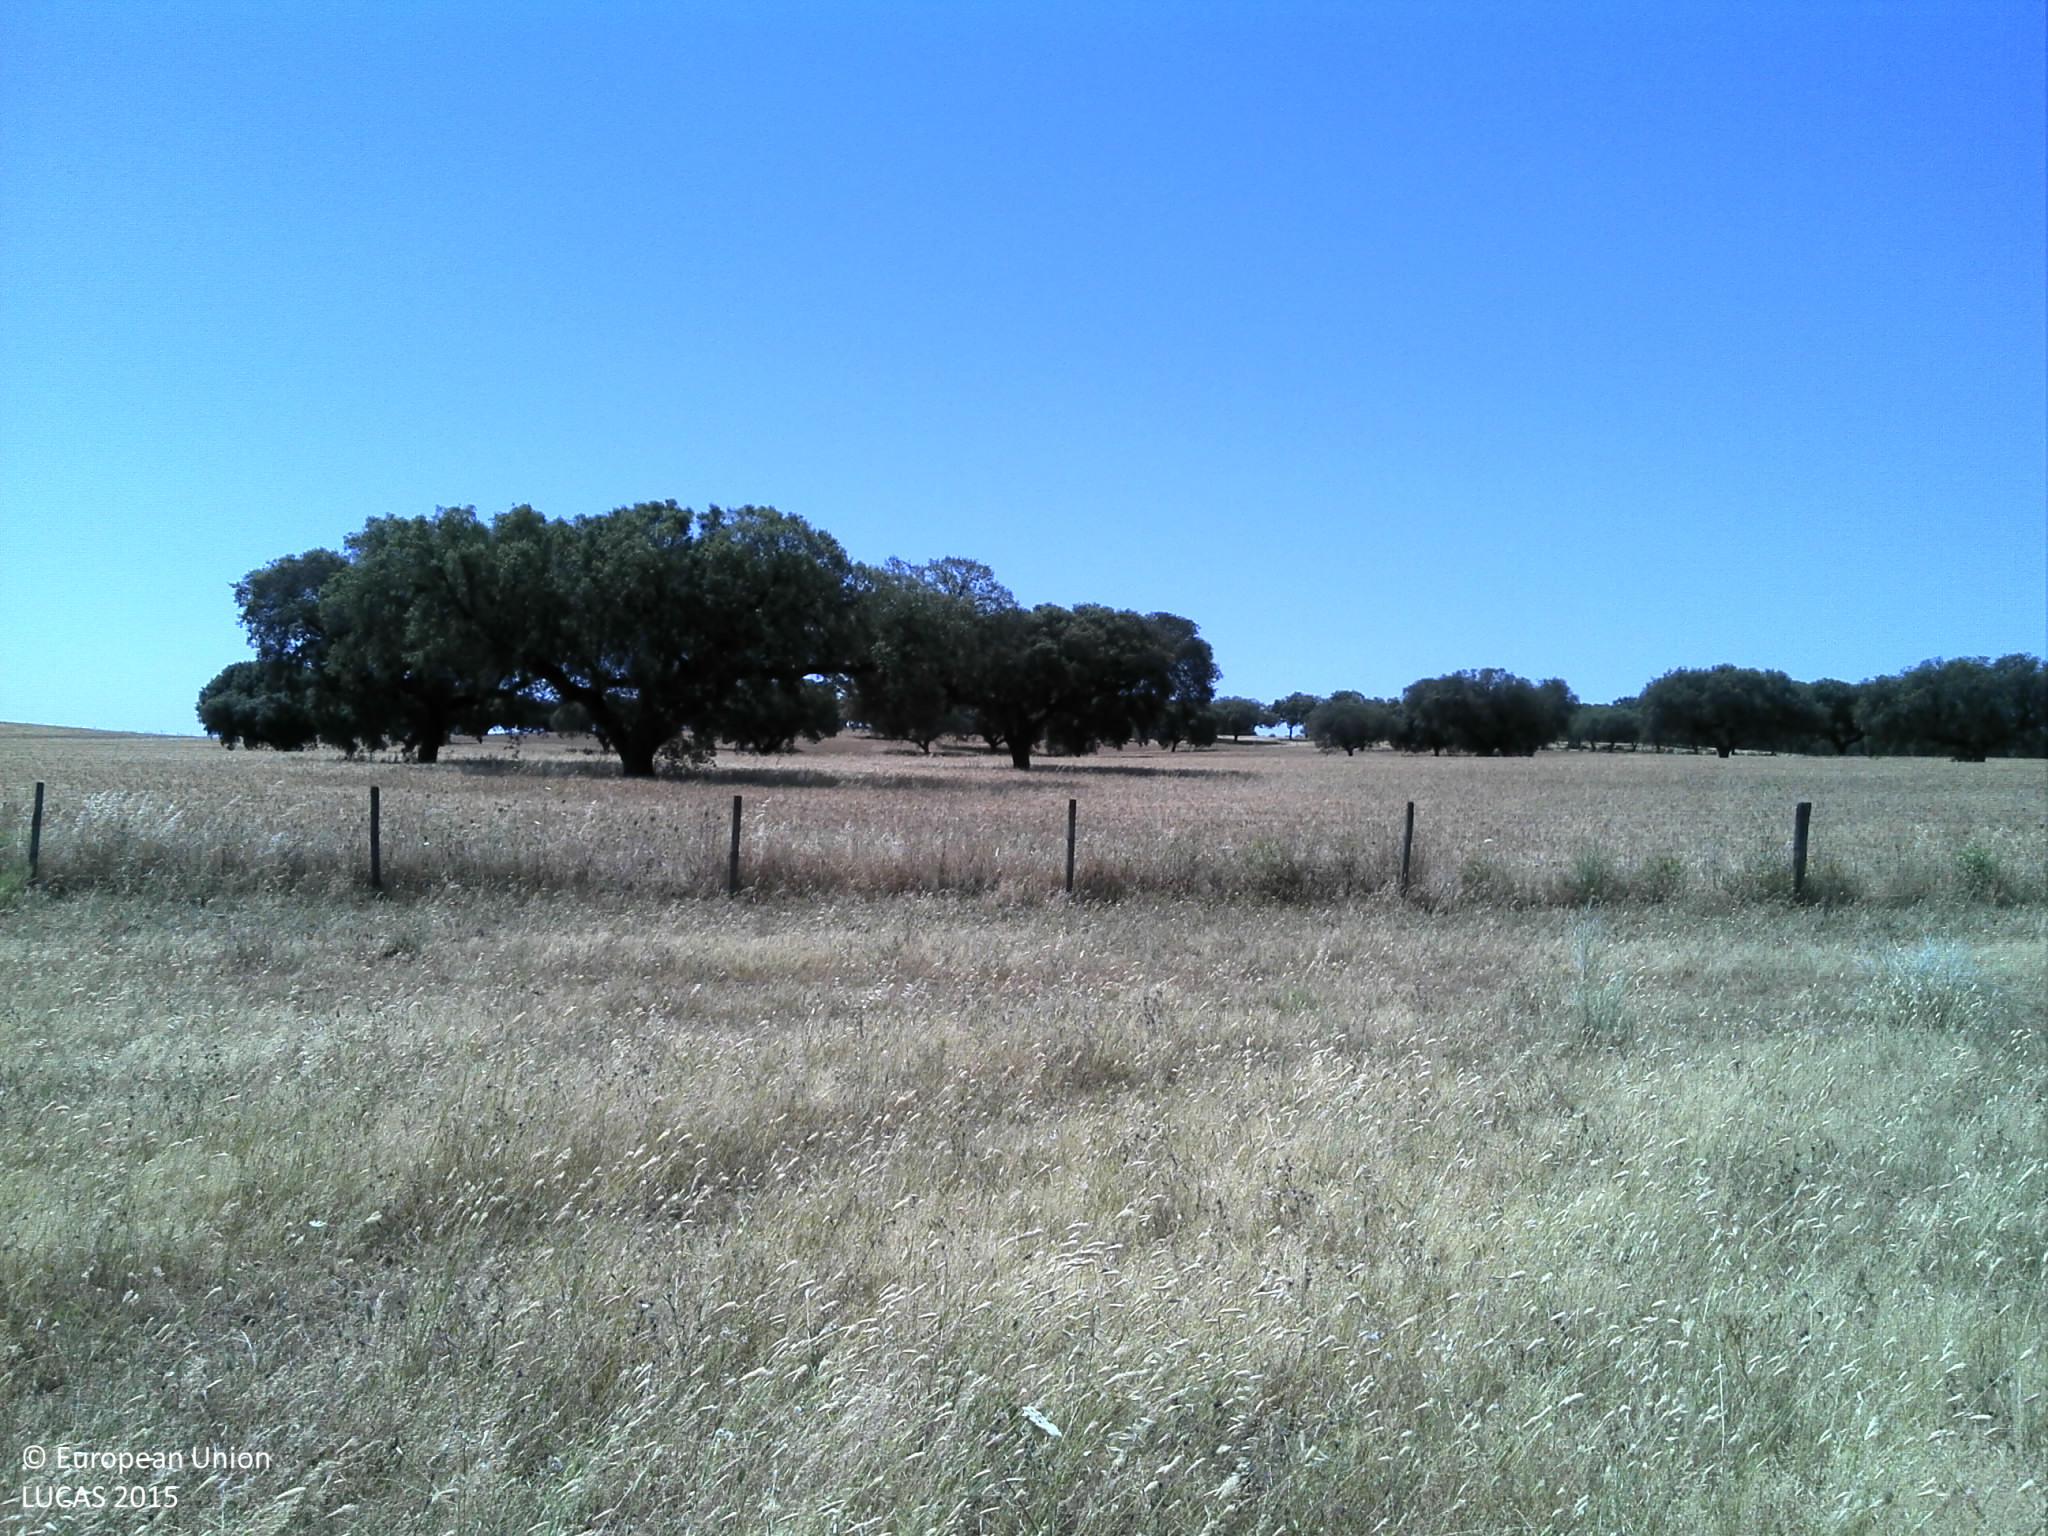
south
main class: Grassland
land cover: Grassland without tree/shrub cover
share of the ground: > 75 %
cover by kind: herbaceous plants 80 %, unconsolidated bare surface 20 %
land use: Agriculture (excluding fallow land and kitchen gardens)
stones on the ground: < 10 %
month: May
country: PT
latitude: 39.0295
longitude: -7.6107
